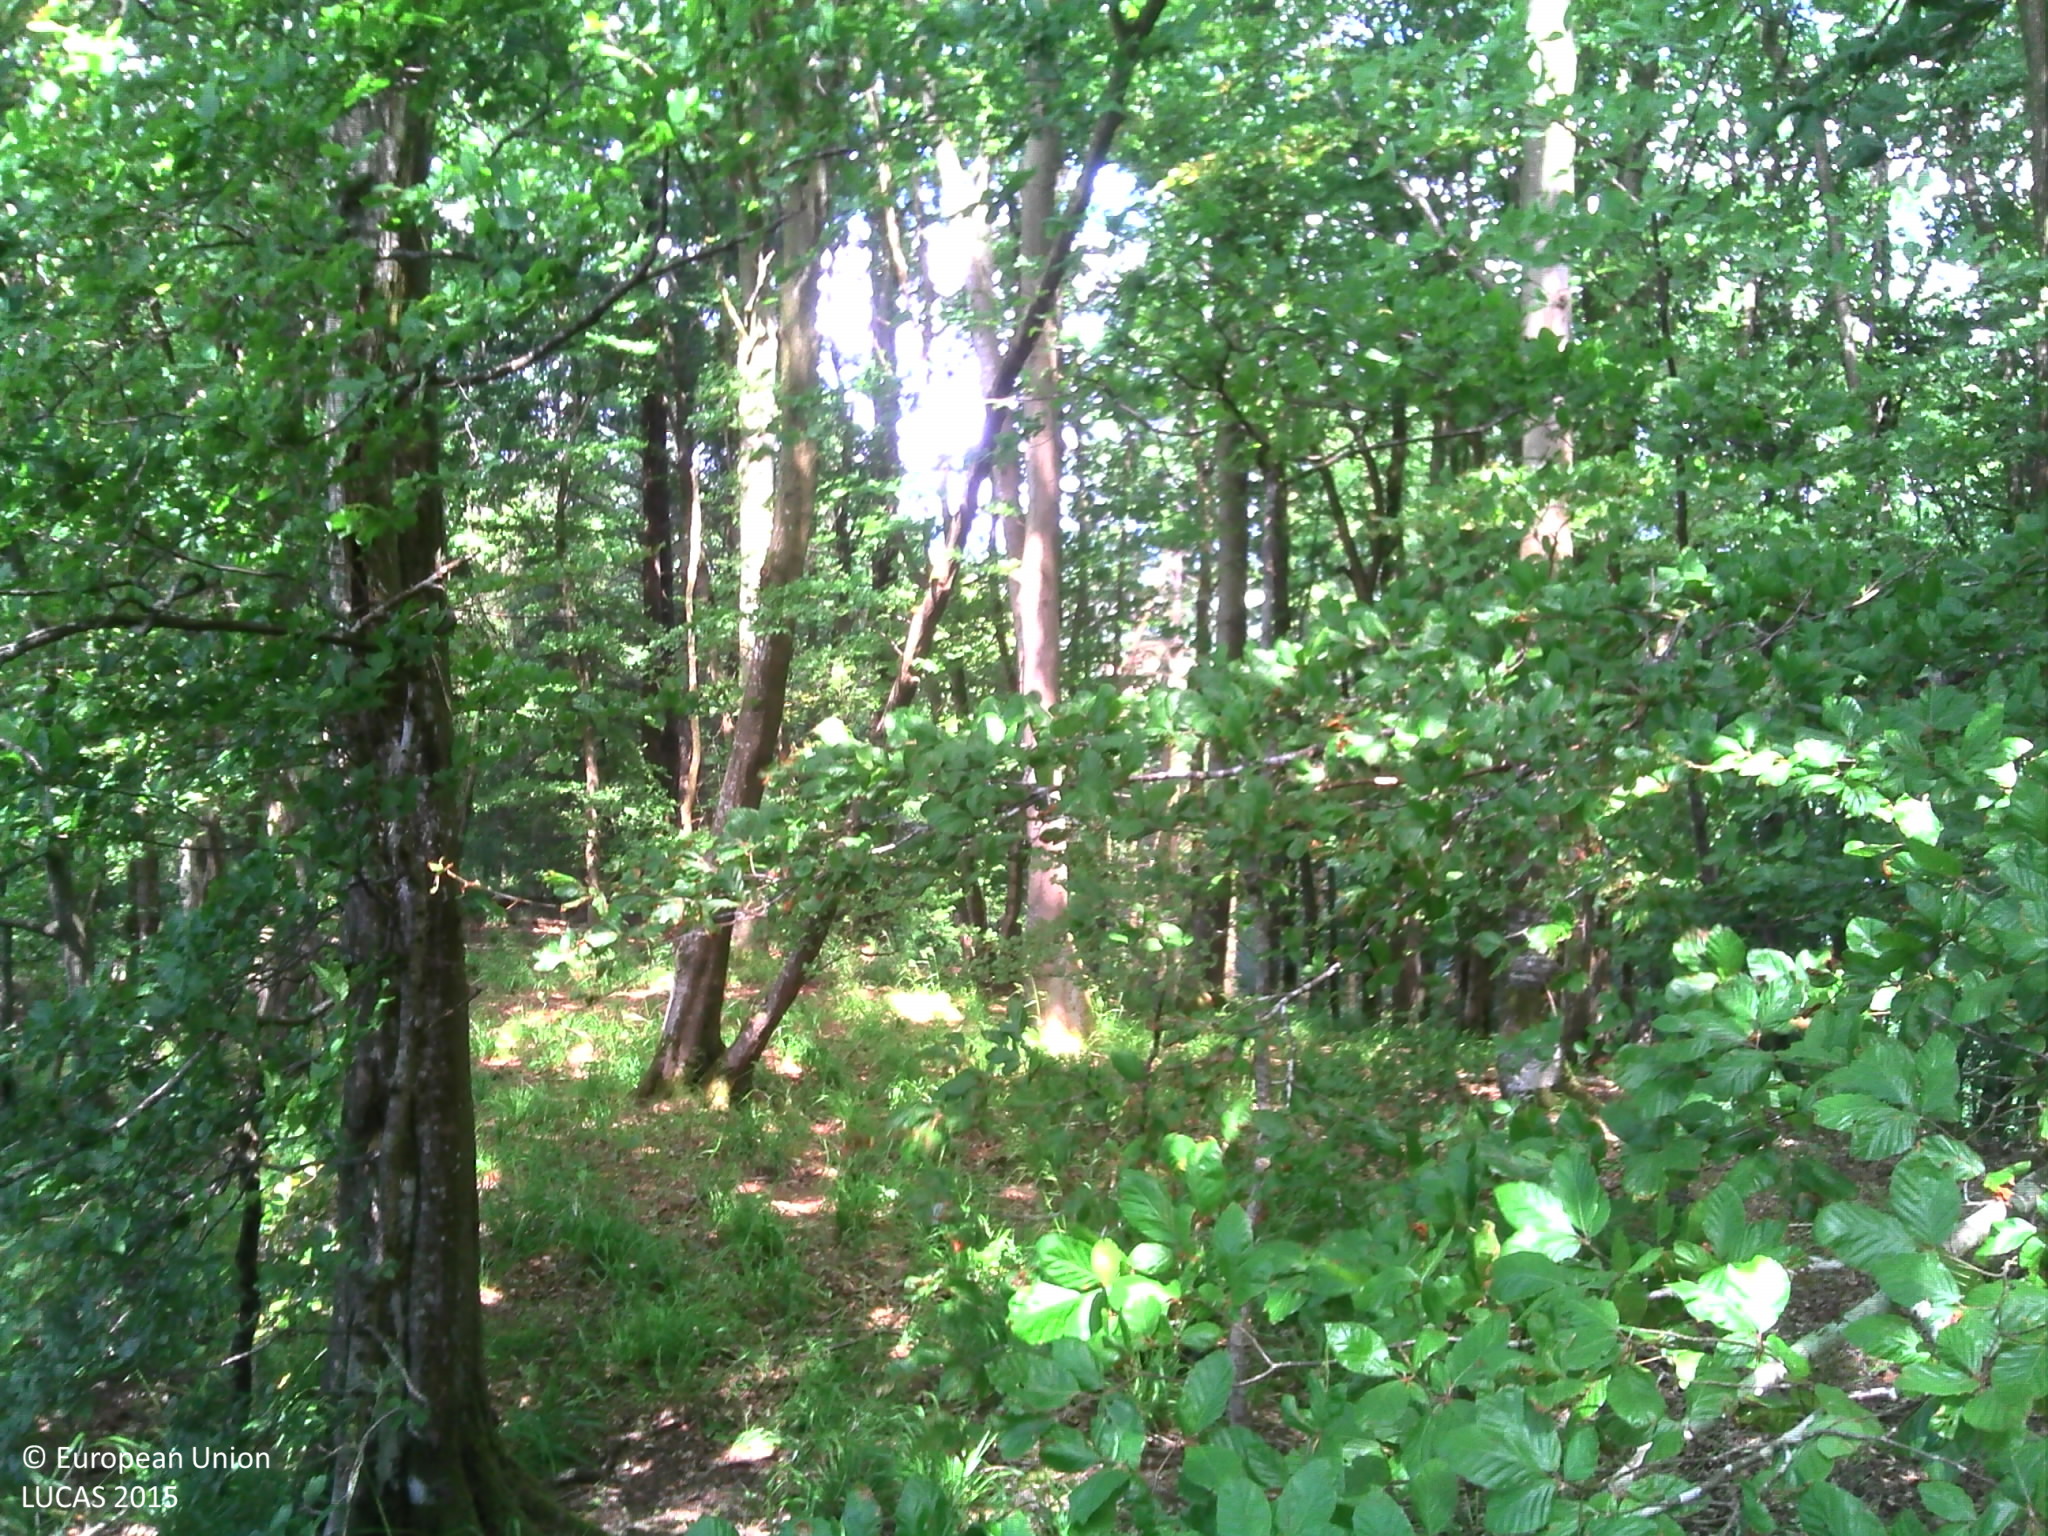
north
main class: Woodland
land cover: Broadleaved woodland
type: beech forest
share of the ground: > 75 %
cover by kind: broadleaved forest trees 85 %, coniferous forest trees 10 %, herbaceous plants 5 %
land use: Forestry
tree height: > 5 m
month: June
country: LU
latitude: 49.8932
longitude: 5.8647
